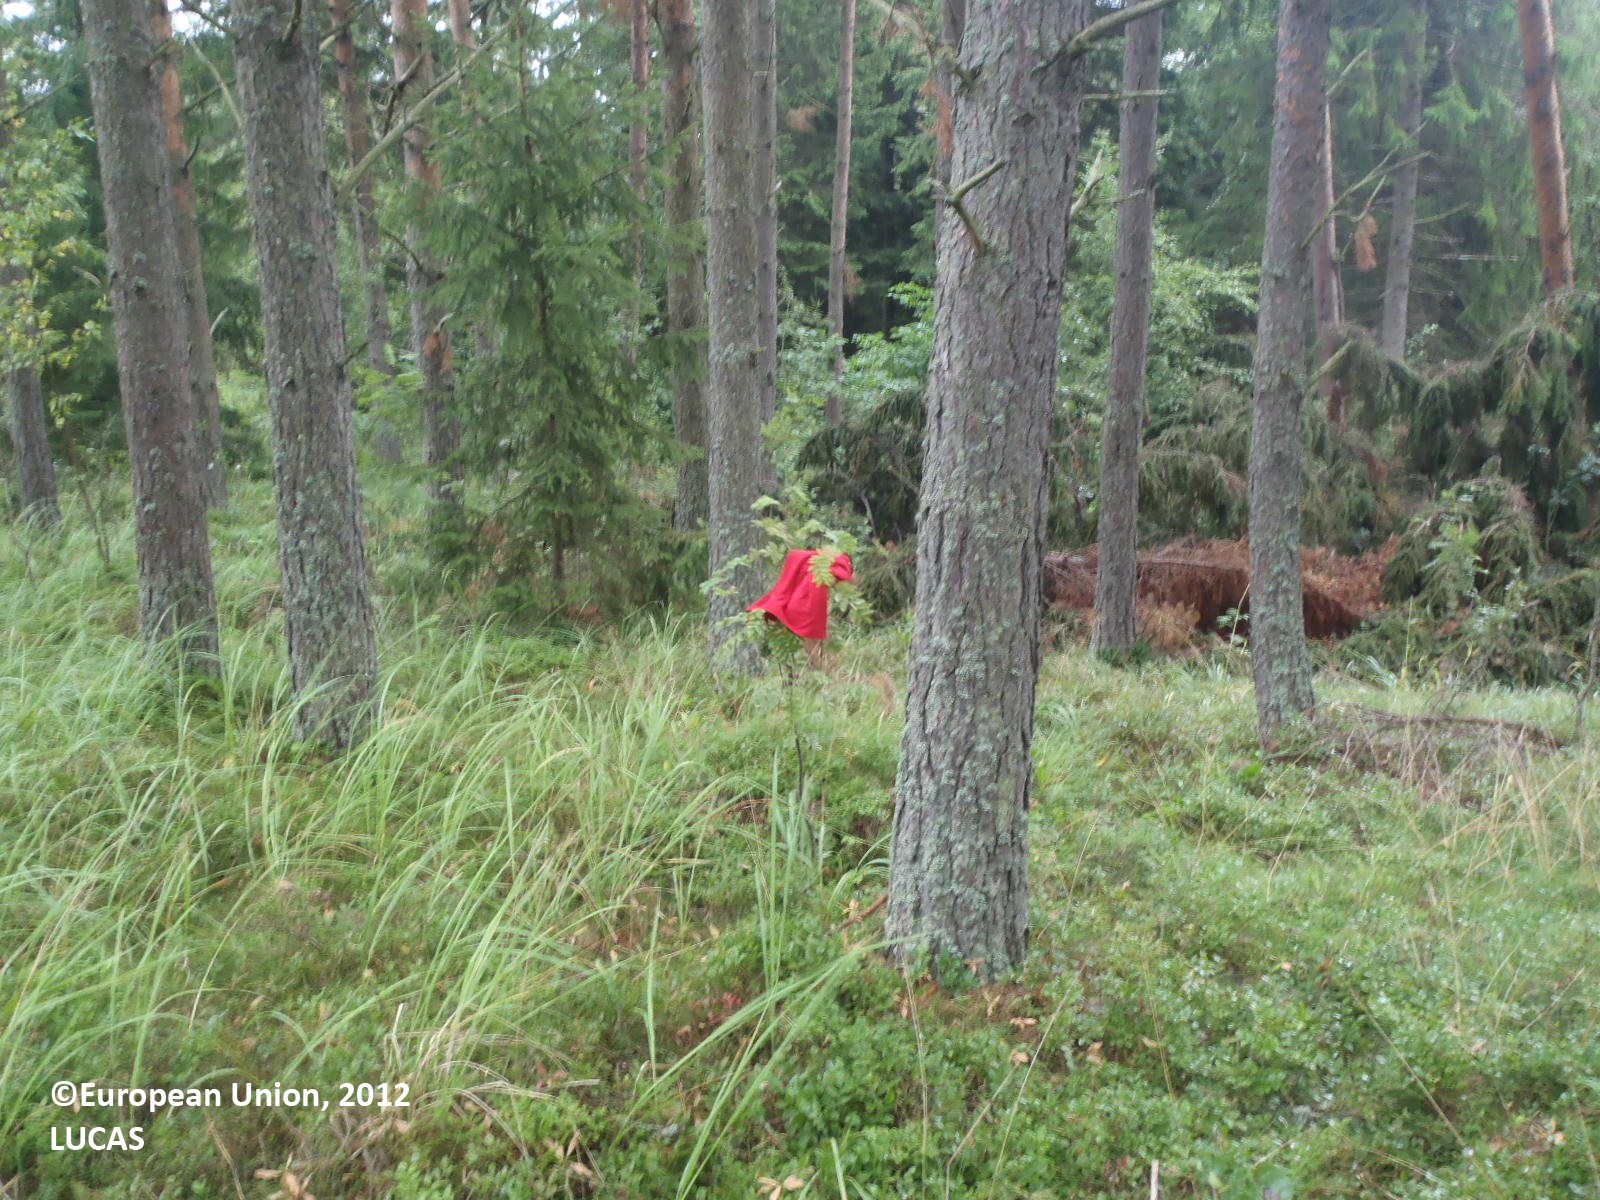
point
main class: Woodland
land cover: Pine dominated coniferous woodland
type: hemiboreal forest and nemoral coniferous forest and mixed broadleaved-coniferous forest
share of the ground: > 75 %
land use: Forestry
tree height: > 5 m
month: August
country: FI
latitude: 60.3187
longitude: 20.9321
